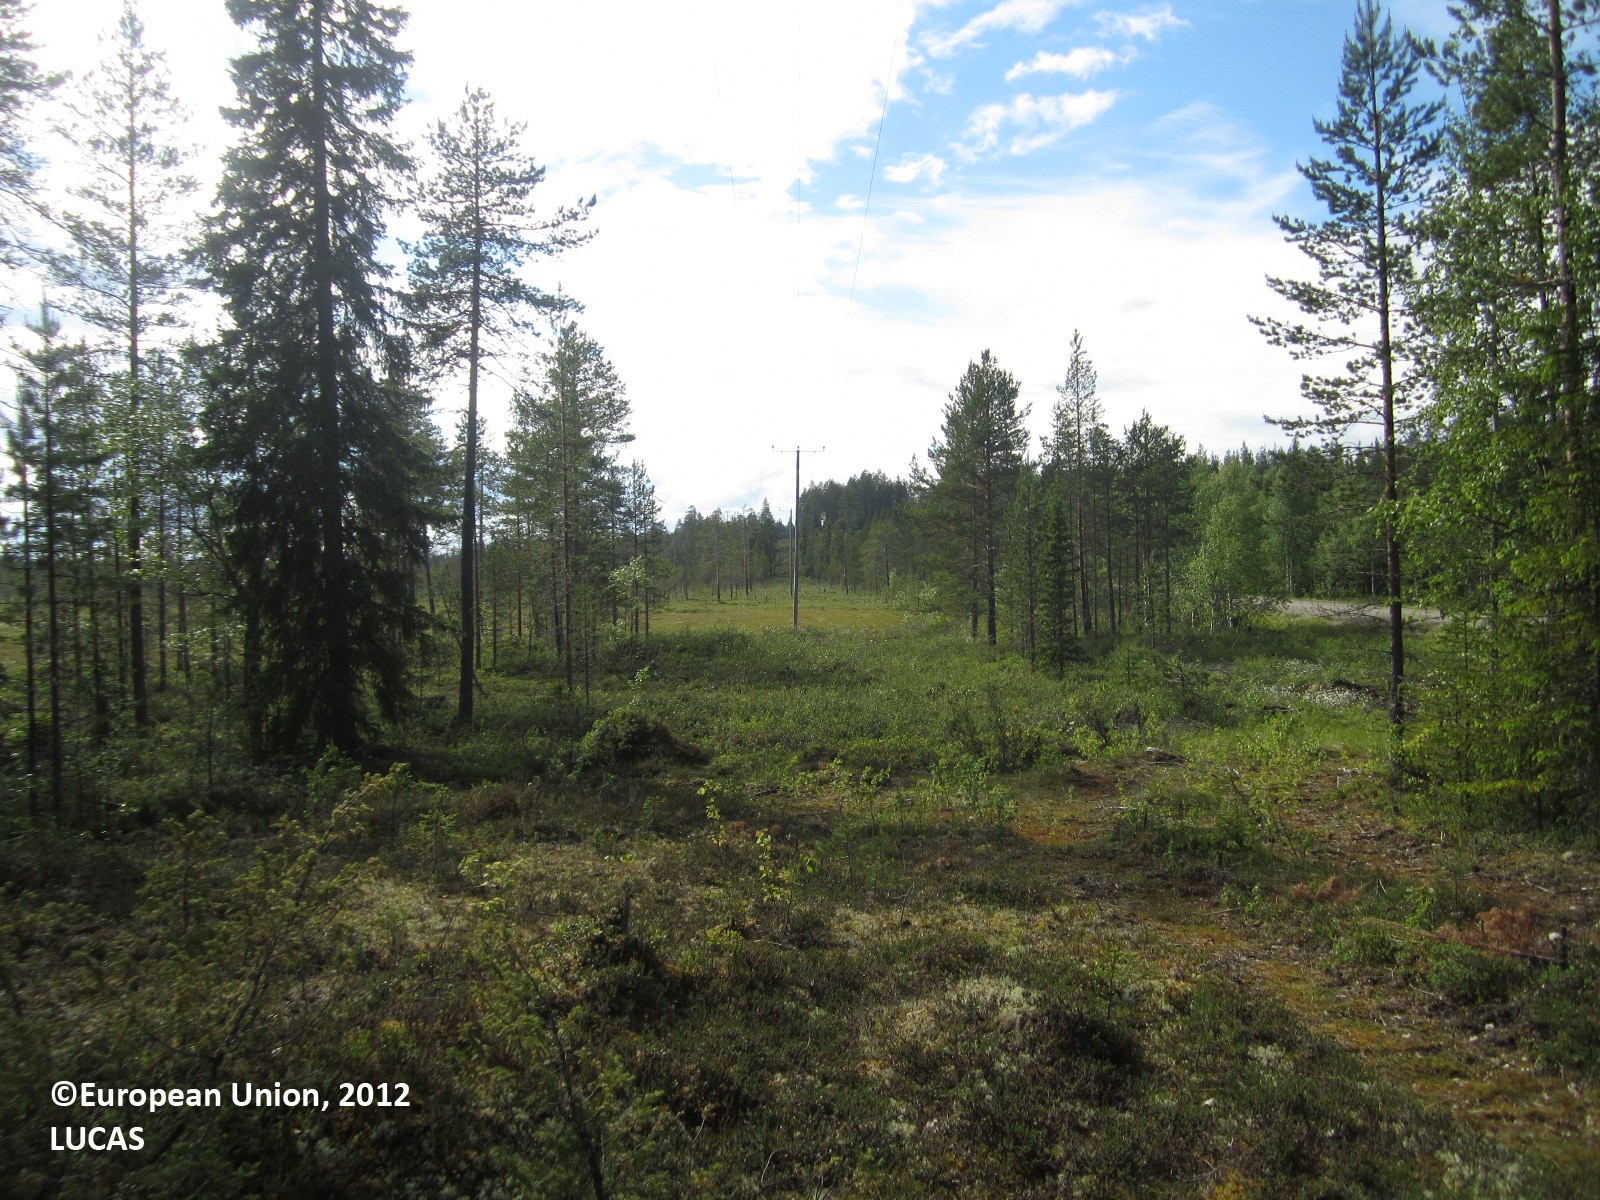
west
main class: Shrubland
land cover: Shrubland without tree cover
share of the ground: 50 - 75 %
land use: Energy production
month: June
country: FI
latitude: 64.6412
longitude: 30.0077
